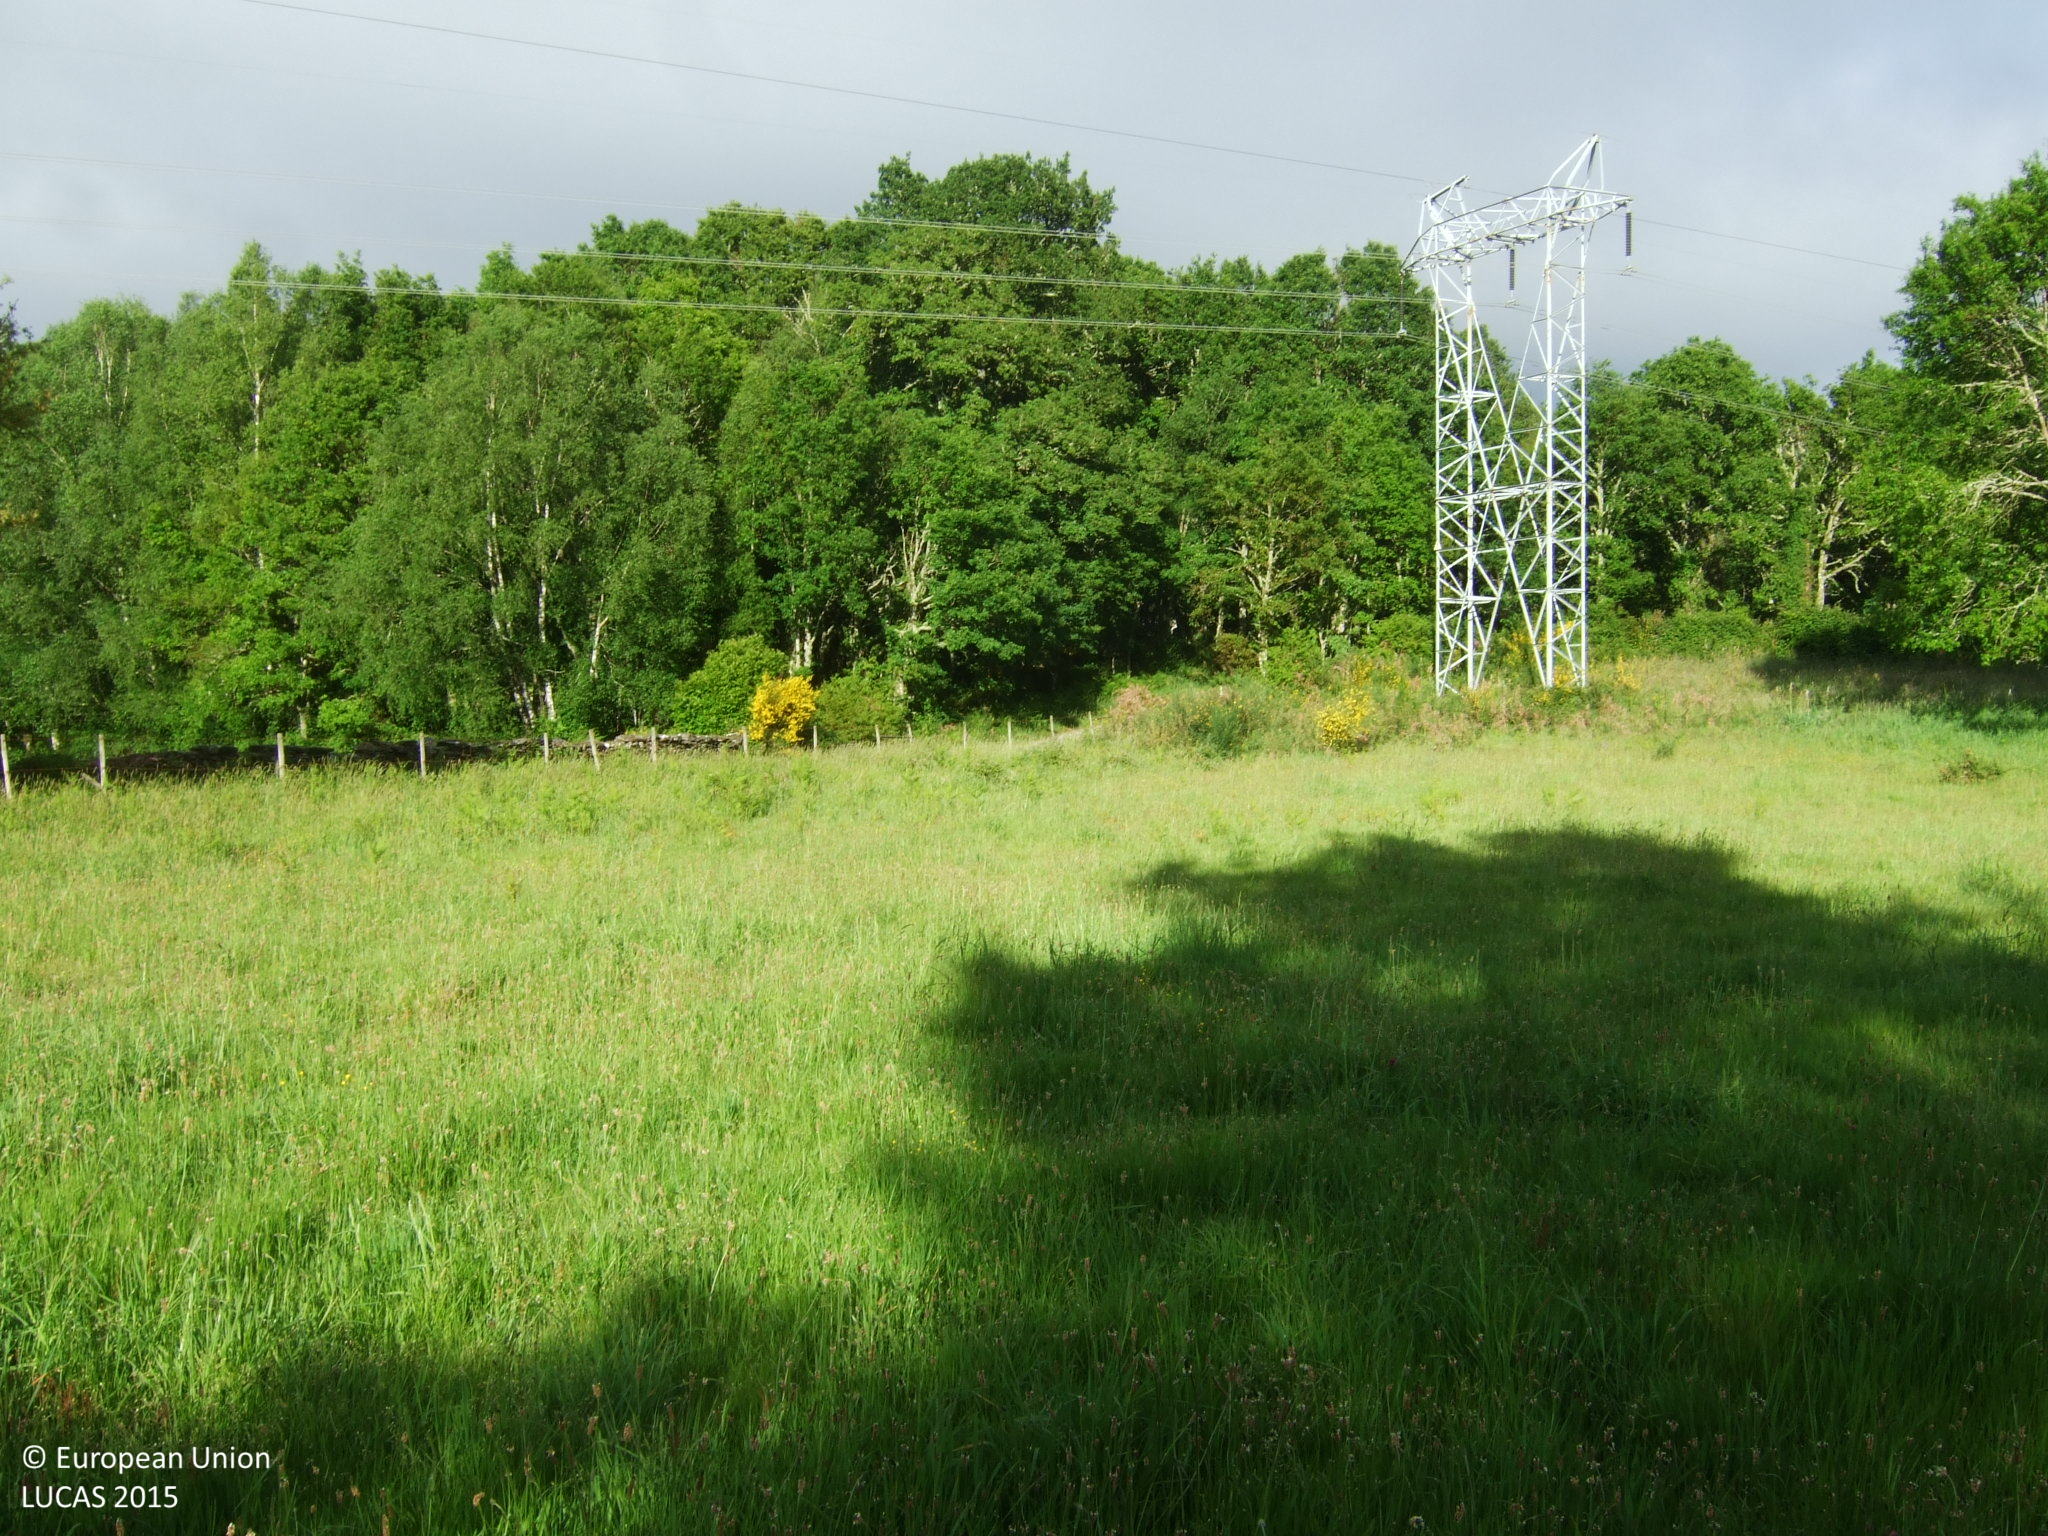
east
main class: Grassland
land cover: Grassland without tree/shrub cover
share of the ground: > 75 %
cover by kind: herbaceous plants 100 %
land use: Agriculture (excluding fallow land and kitchen gardens)
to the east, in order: Grassland without tree/shrub cover; Fences; Electric lines; Paved roads, cycling and walking lanes; Groves; Broadleaved woodland; Dry stone walls; Grassland without tree/shrub cover; Groves; Managed hedges; Artificial constructions in urban areas
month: May
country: ES
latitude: 43.2852
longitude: -7.7461
